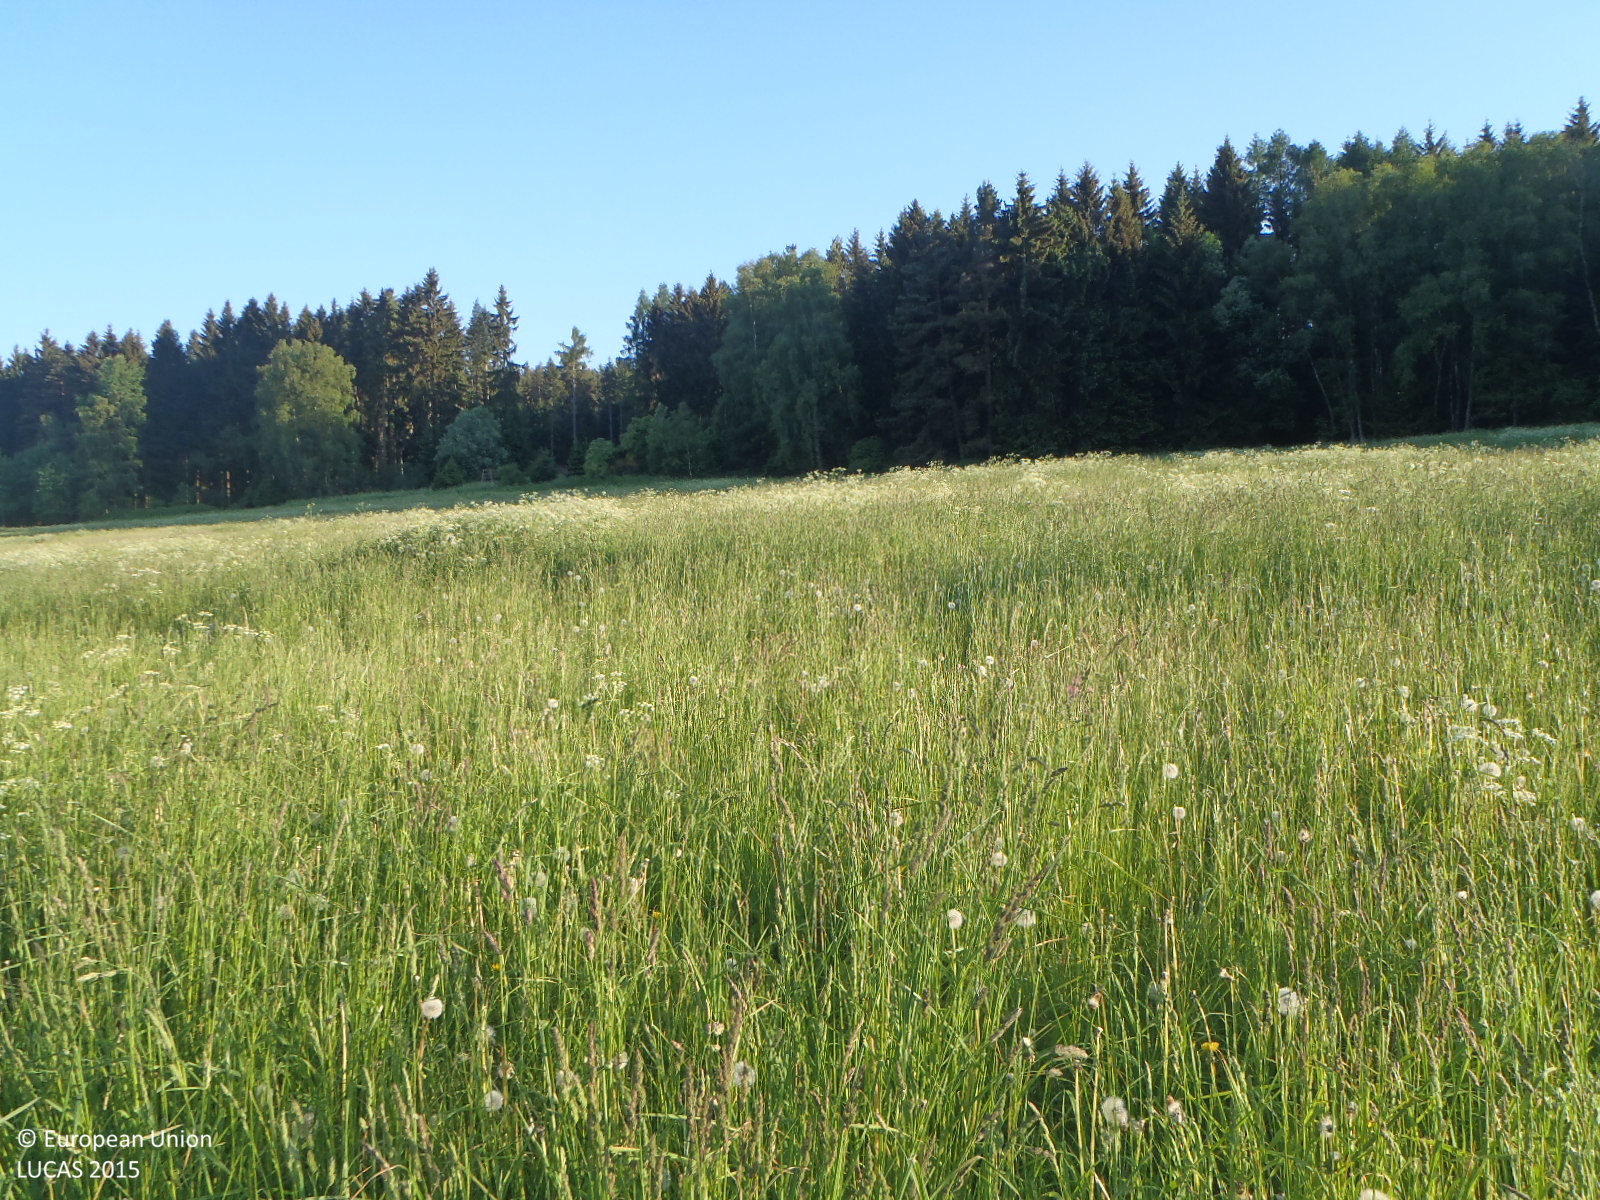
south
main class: Grassland
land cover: Grassland without tree/shrub cover
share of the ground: > 75 %
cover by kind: herbaceous plants 100 %
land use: Agriculture (excluding fallow land and kitchen gardens)
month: June
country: CZ
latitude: 48.6431
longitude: 14.3300
